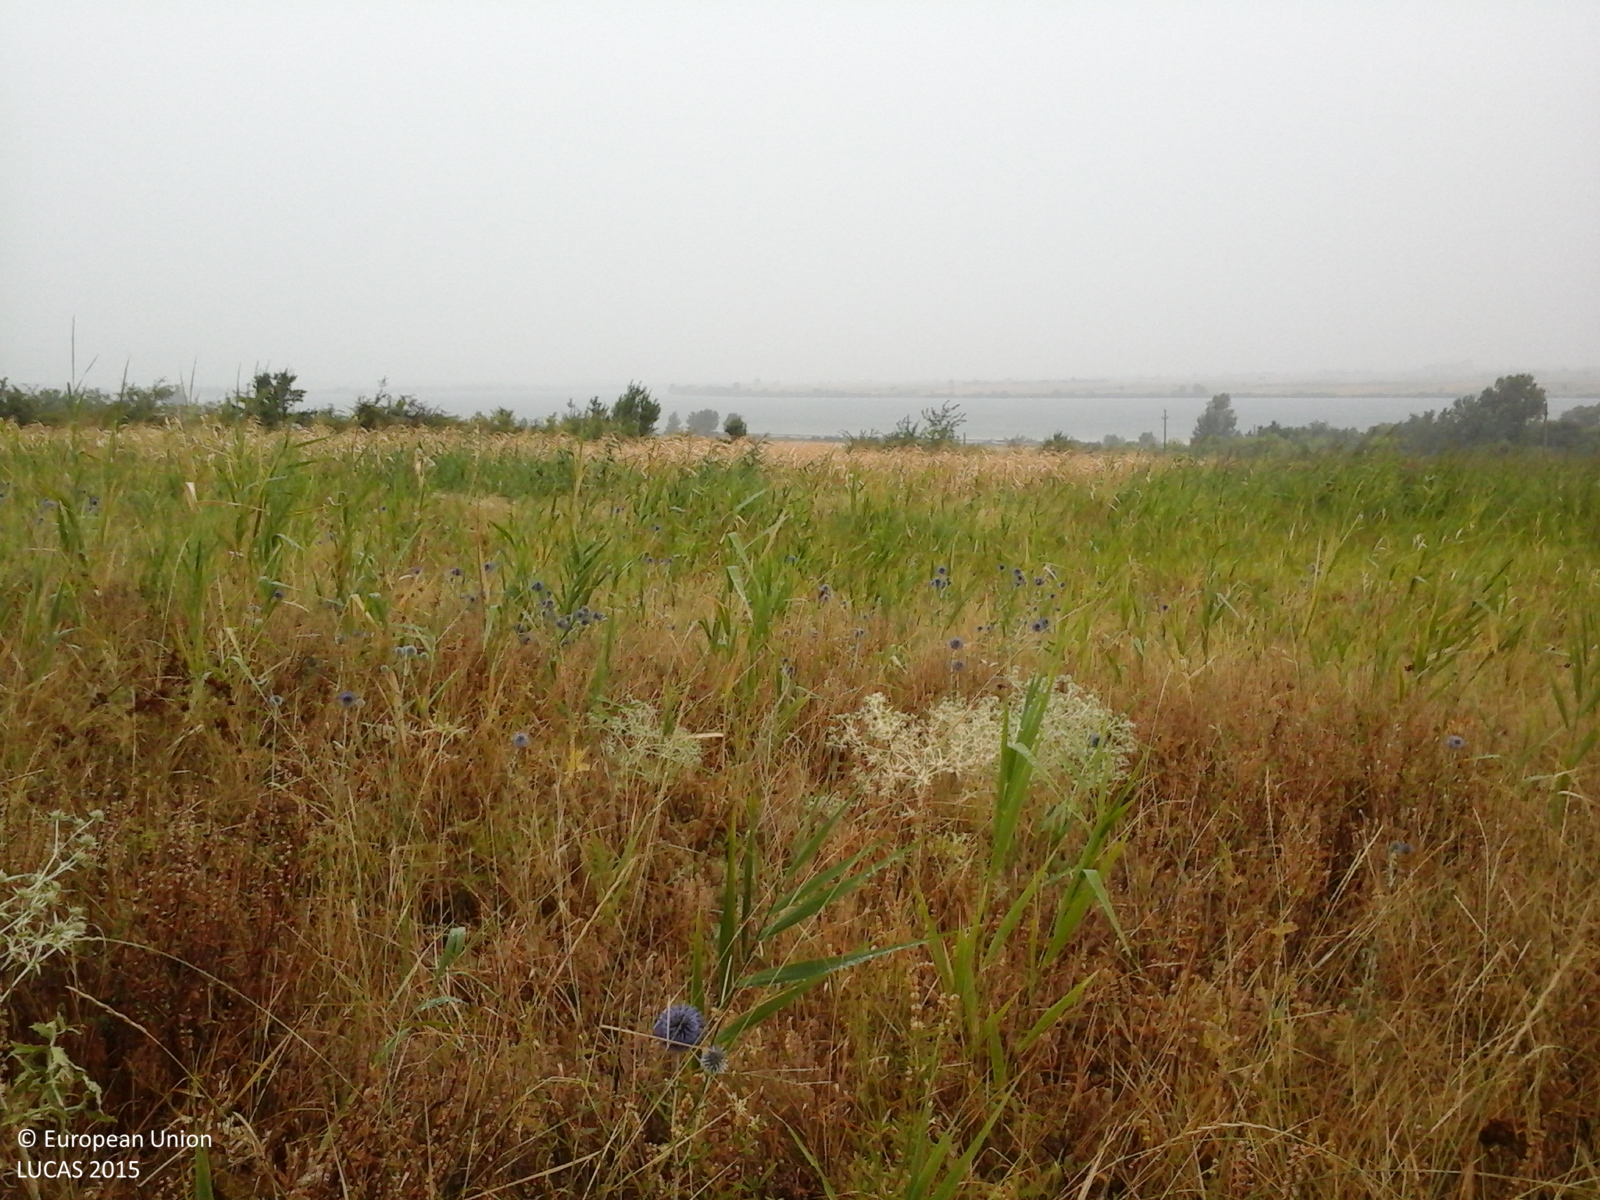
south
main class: Shrubland
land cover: Shrubland with sparse tree cover
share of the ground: > 75 %
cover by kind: shrubs 95 %, broadleaved forest trees 5 %
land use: Semi-natural and natural areas not in use
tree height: < 5 m
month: August
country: RO
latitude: 44.5610
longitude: 22.7712
